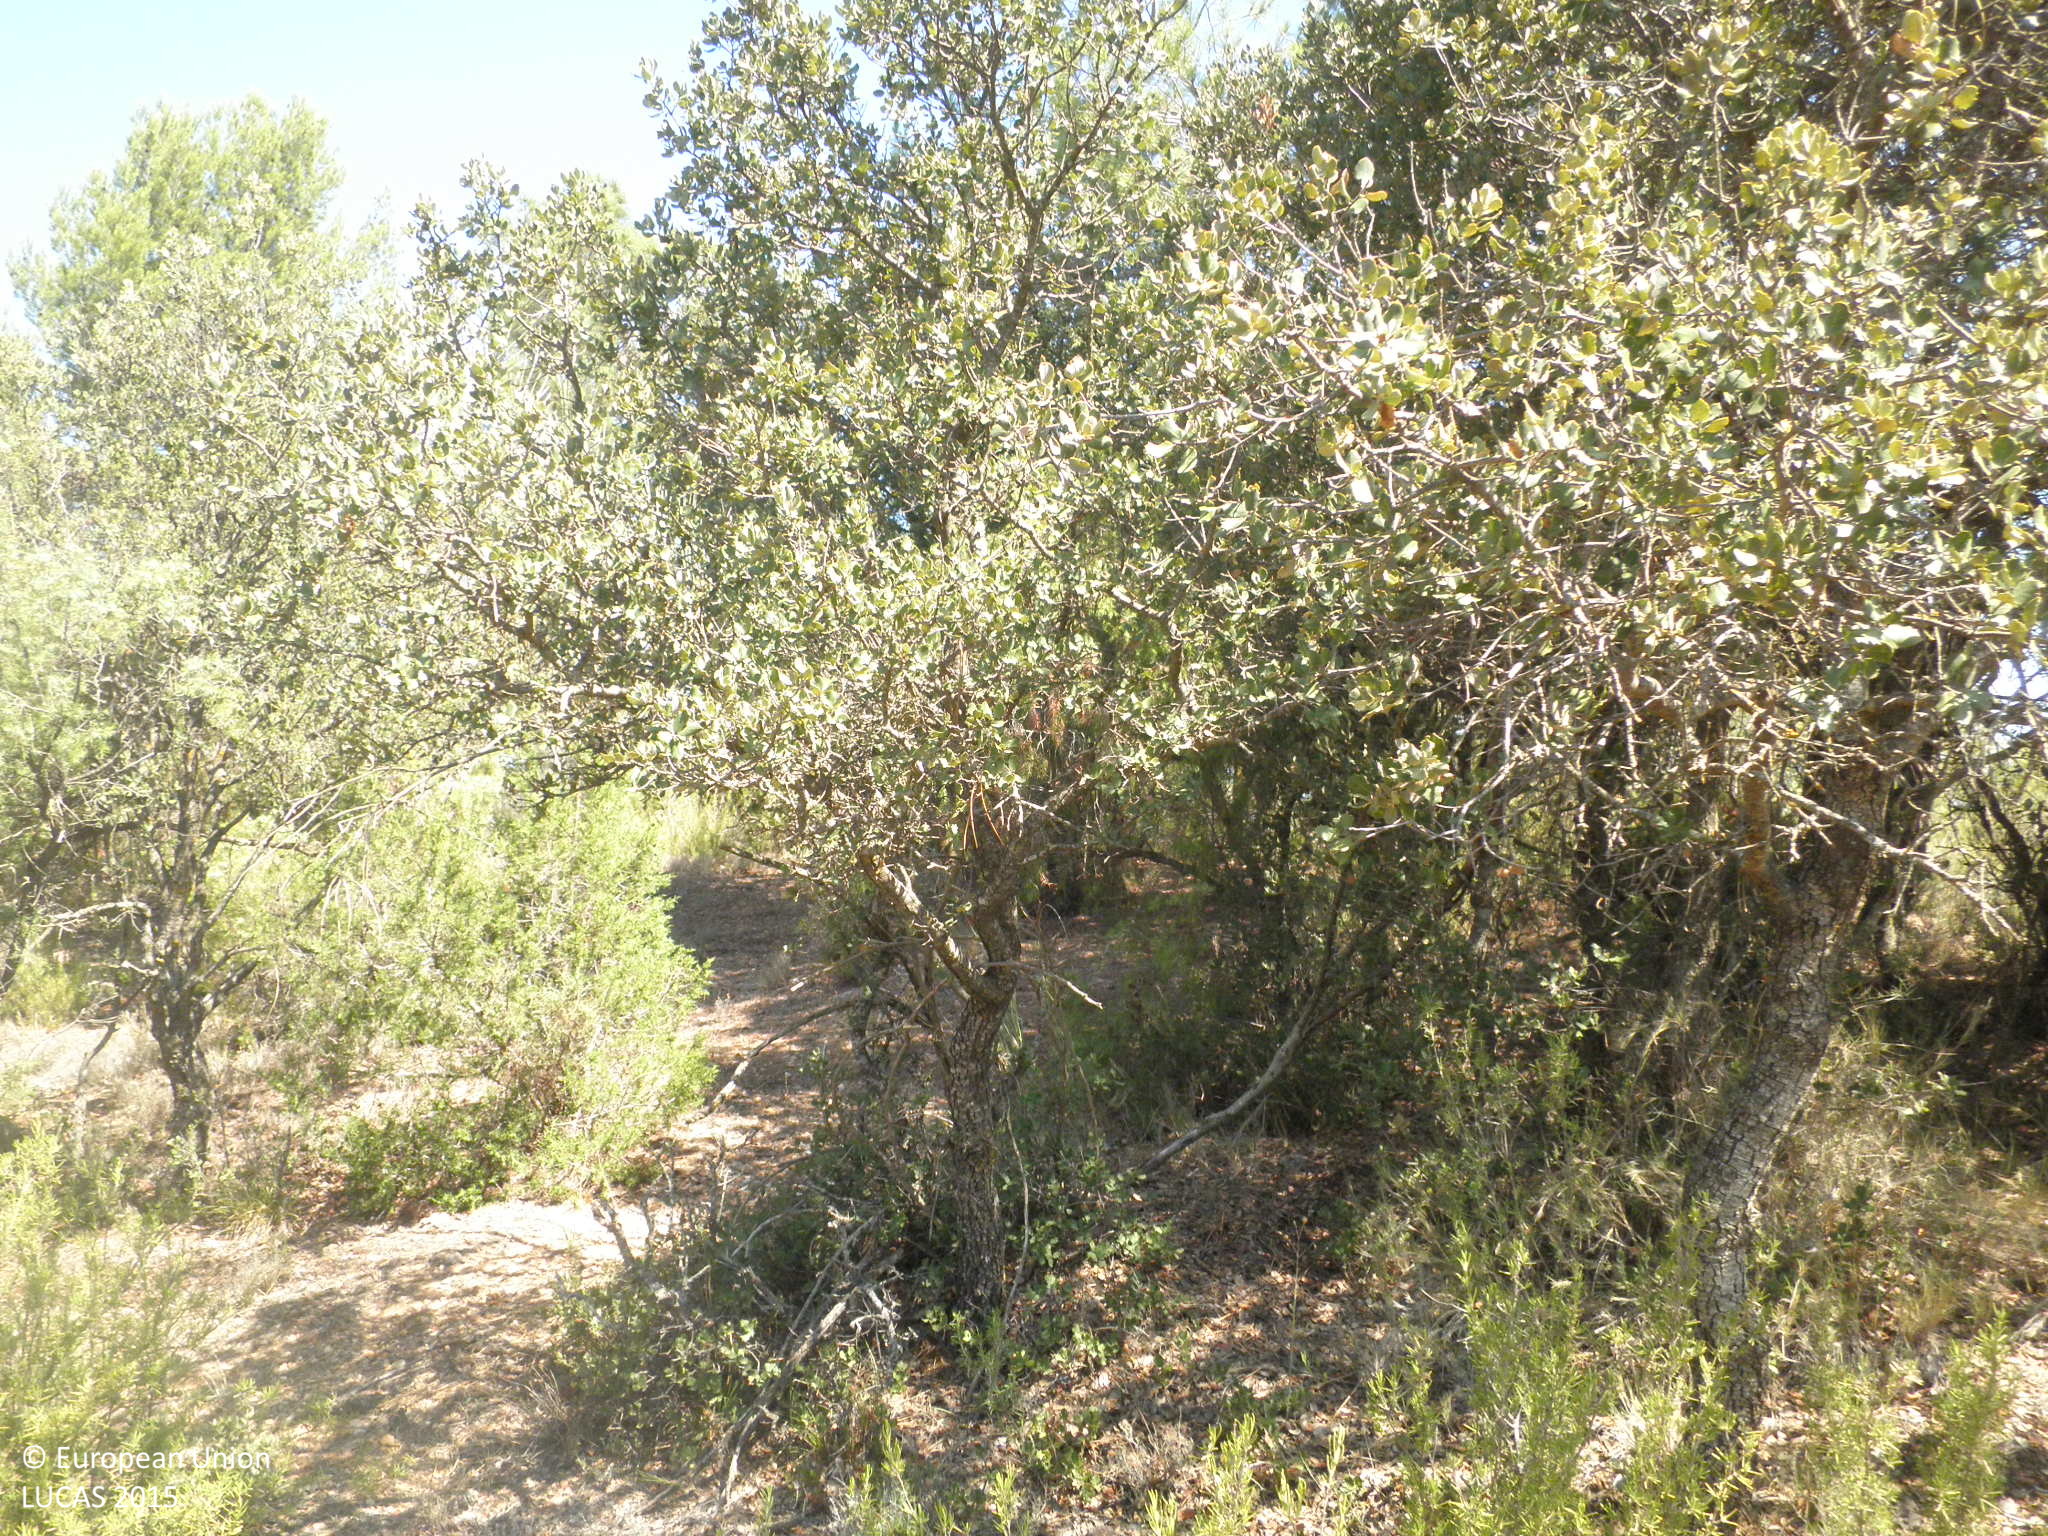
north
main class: Woodland
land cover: Other mixed woodland
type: broadleaved evergreen forest
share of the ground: 25 - 50 %
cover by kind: unconsolidated bare surface 45 %, broadleaved forest trees 20 %, coniferous forest trees 15 %, shrubs 15 %, herbaceous plants 5 %
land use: Semi-natural and natural areas not in use
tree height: > 5 m
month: July
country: ES
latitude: 39.5932
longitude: -1.6155
